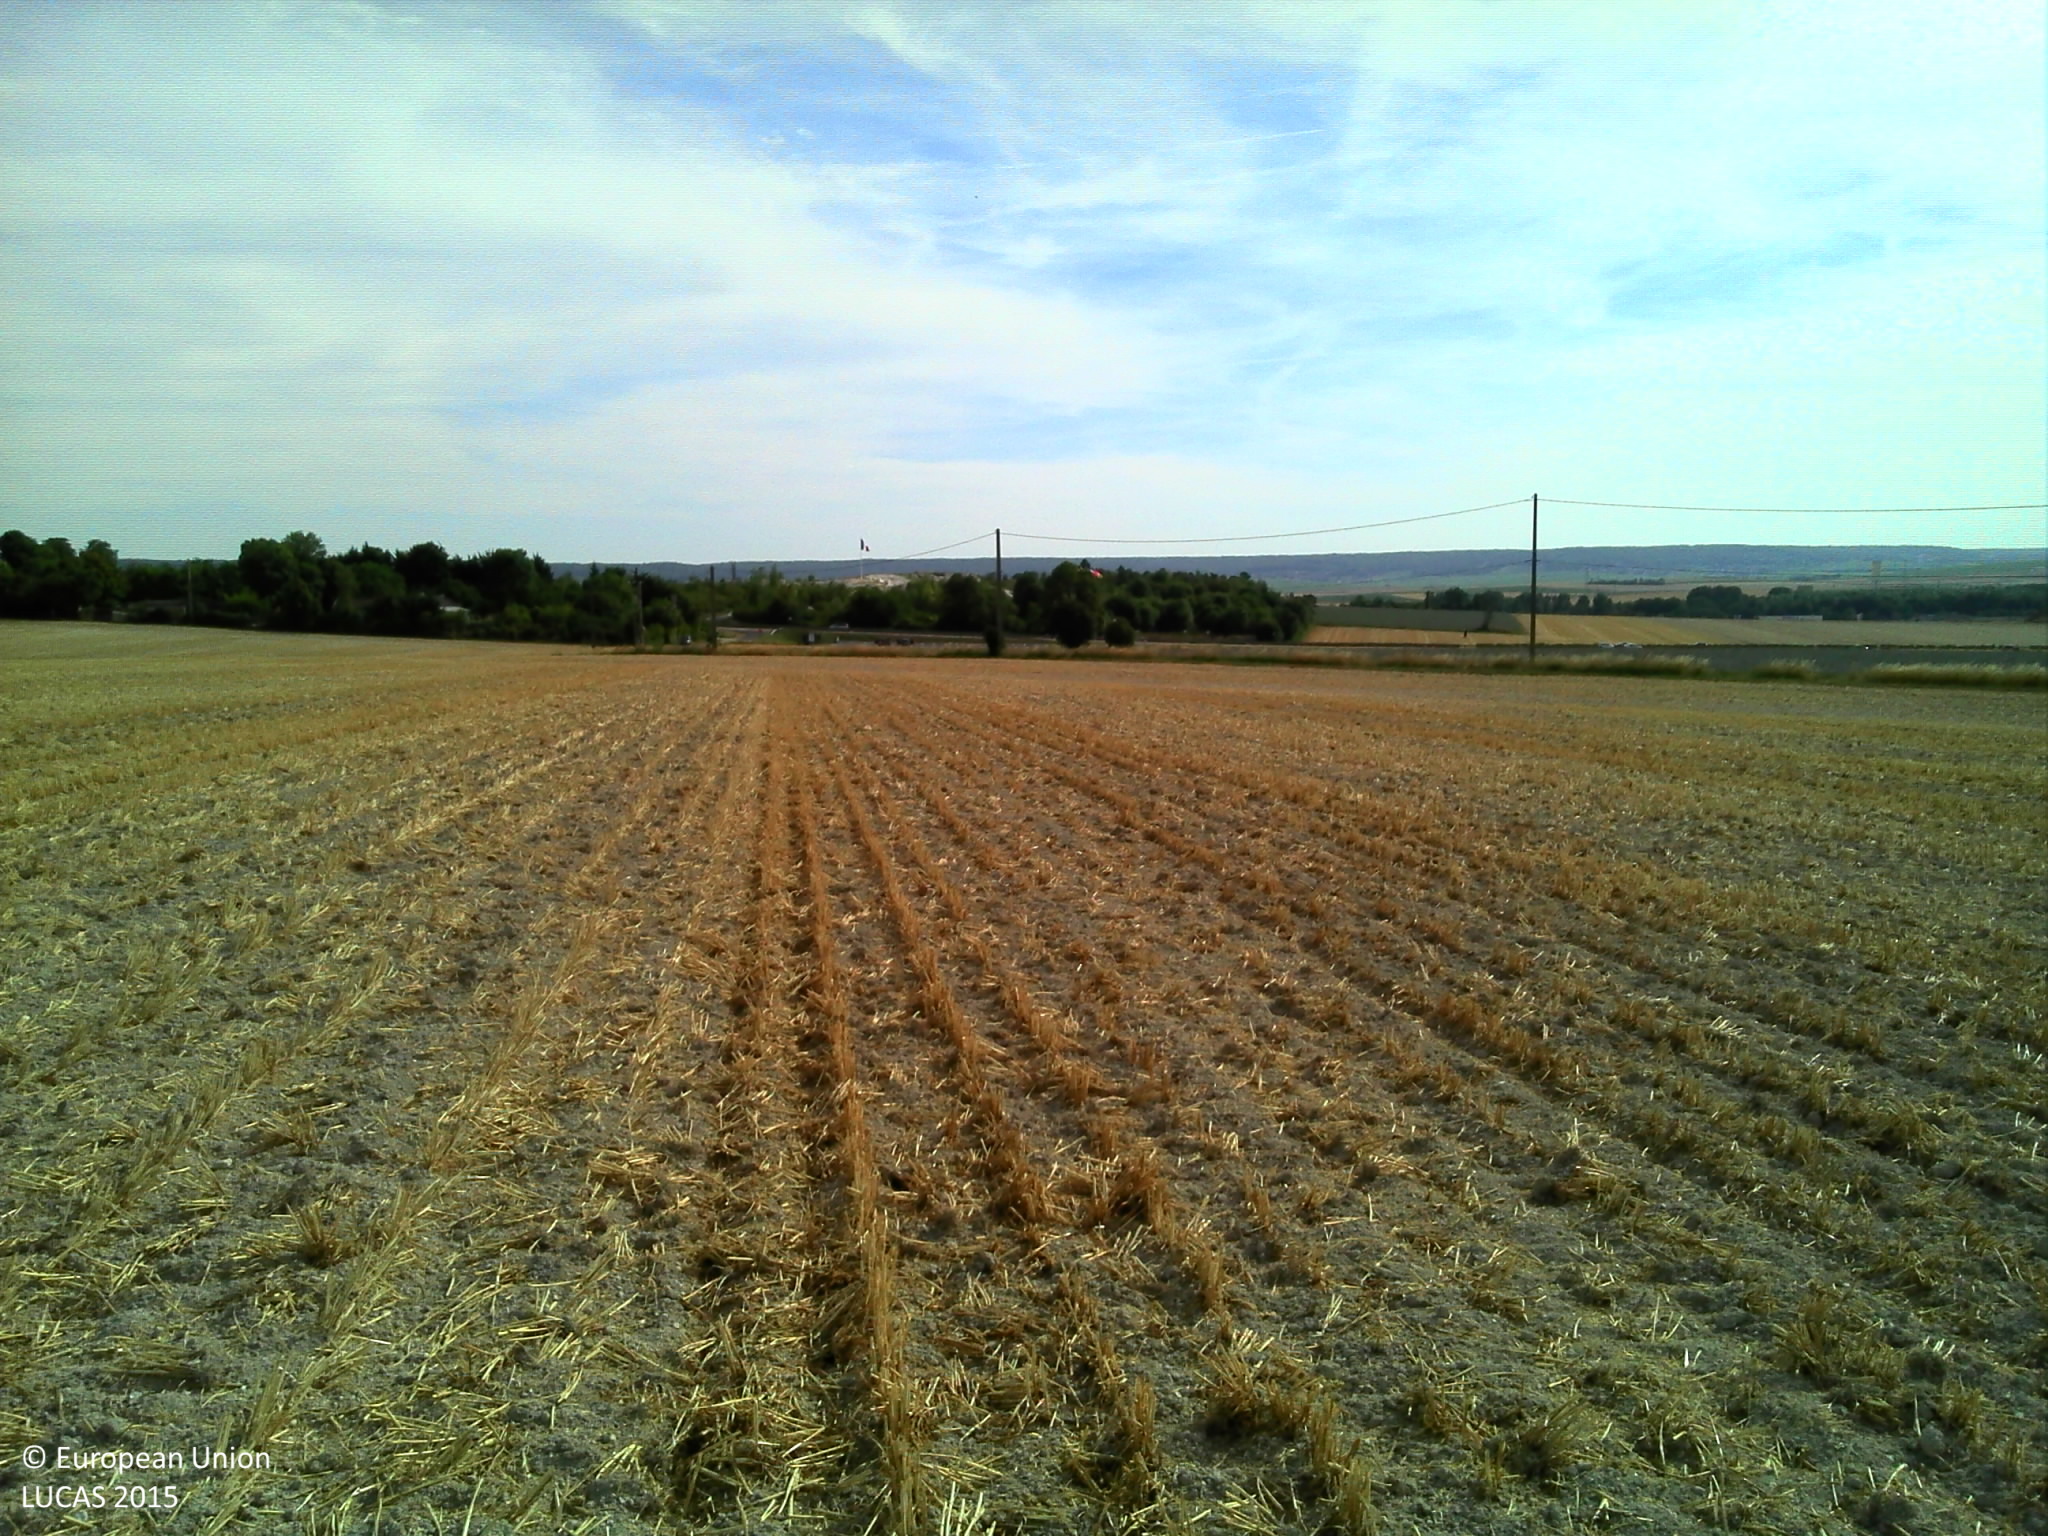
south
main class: Cropland
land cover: Common wheat
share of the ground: > 75 %
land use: Agriculture (excluding fallow land and kitchen gardens)
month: August
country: FR
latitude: 49.2217
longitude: 4.1326
